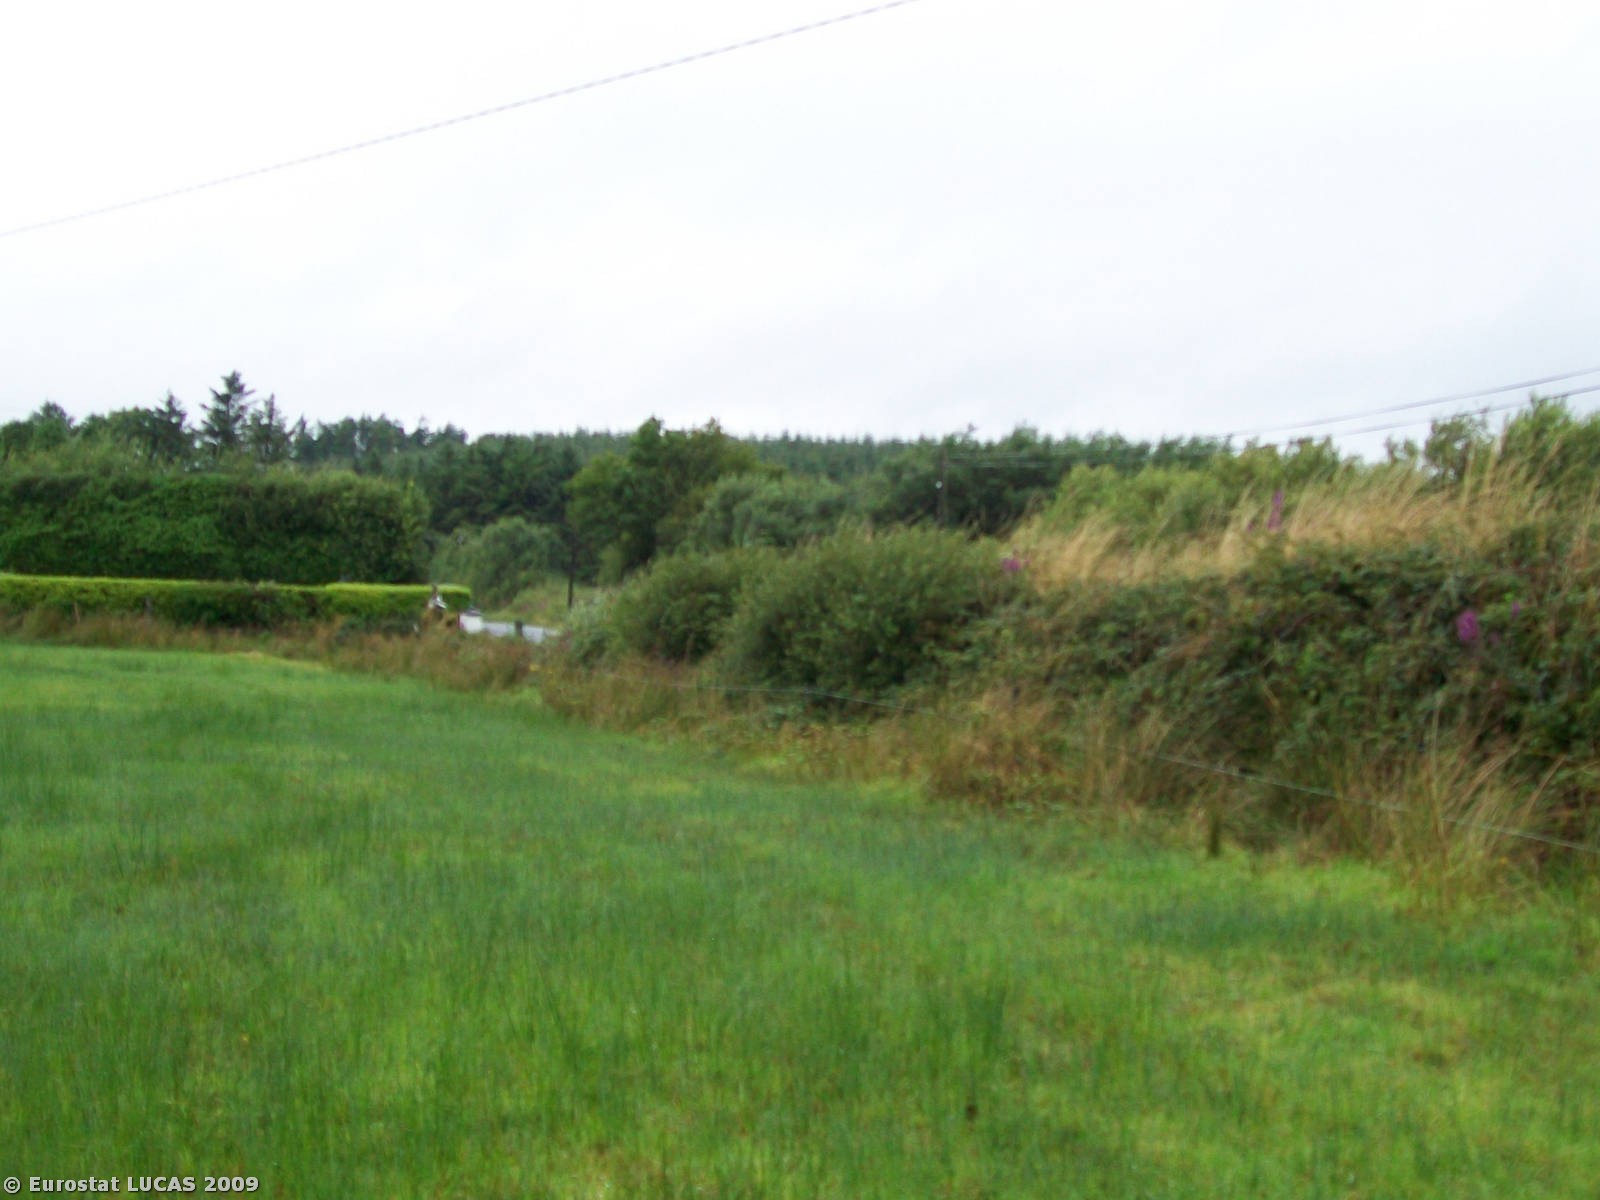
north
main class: Grassland
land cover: Grassland without tree/shrub cover
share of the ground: > 75 %
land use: Agriculture (excluding fallow land and kitchen gardens)
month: August
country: IE
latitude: 52.8338
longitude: -9.1442
